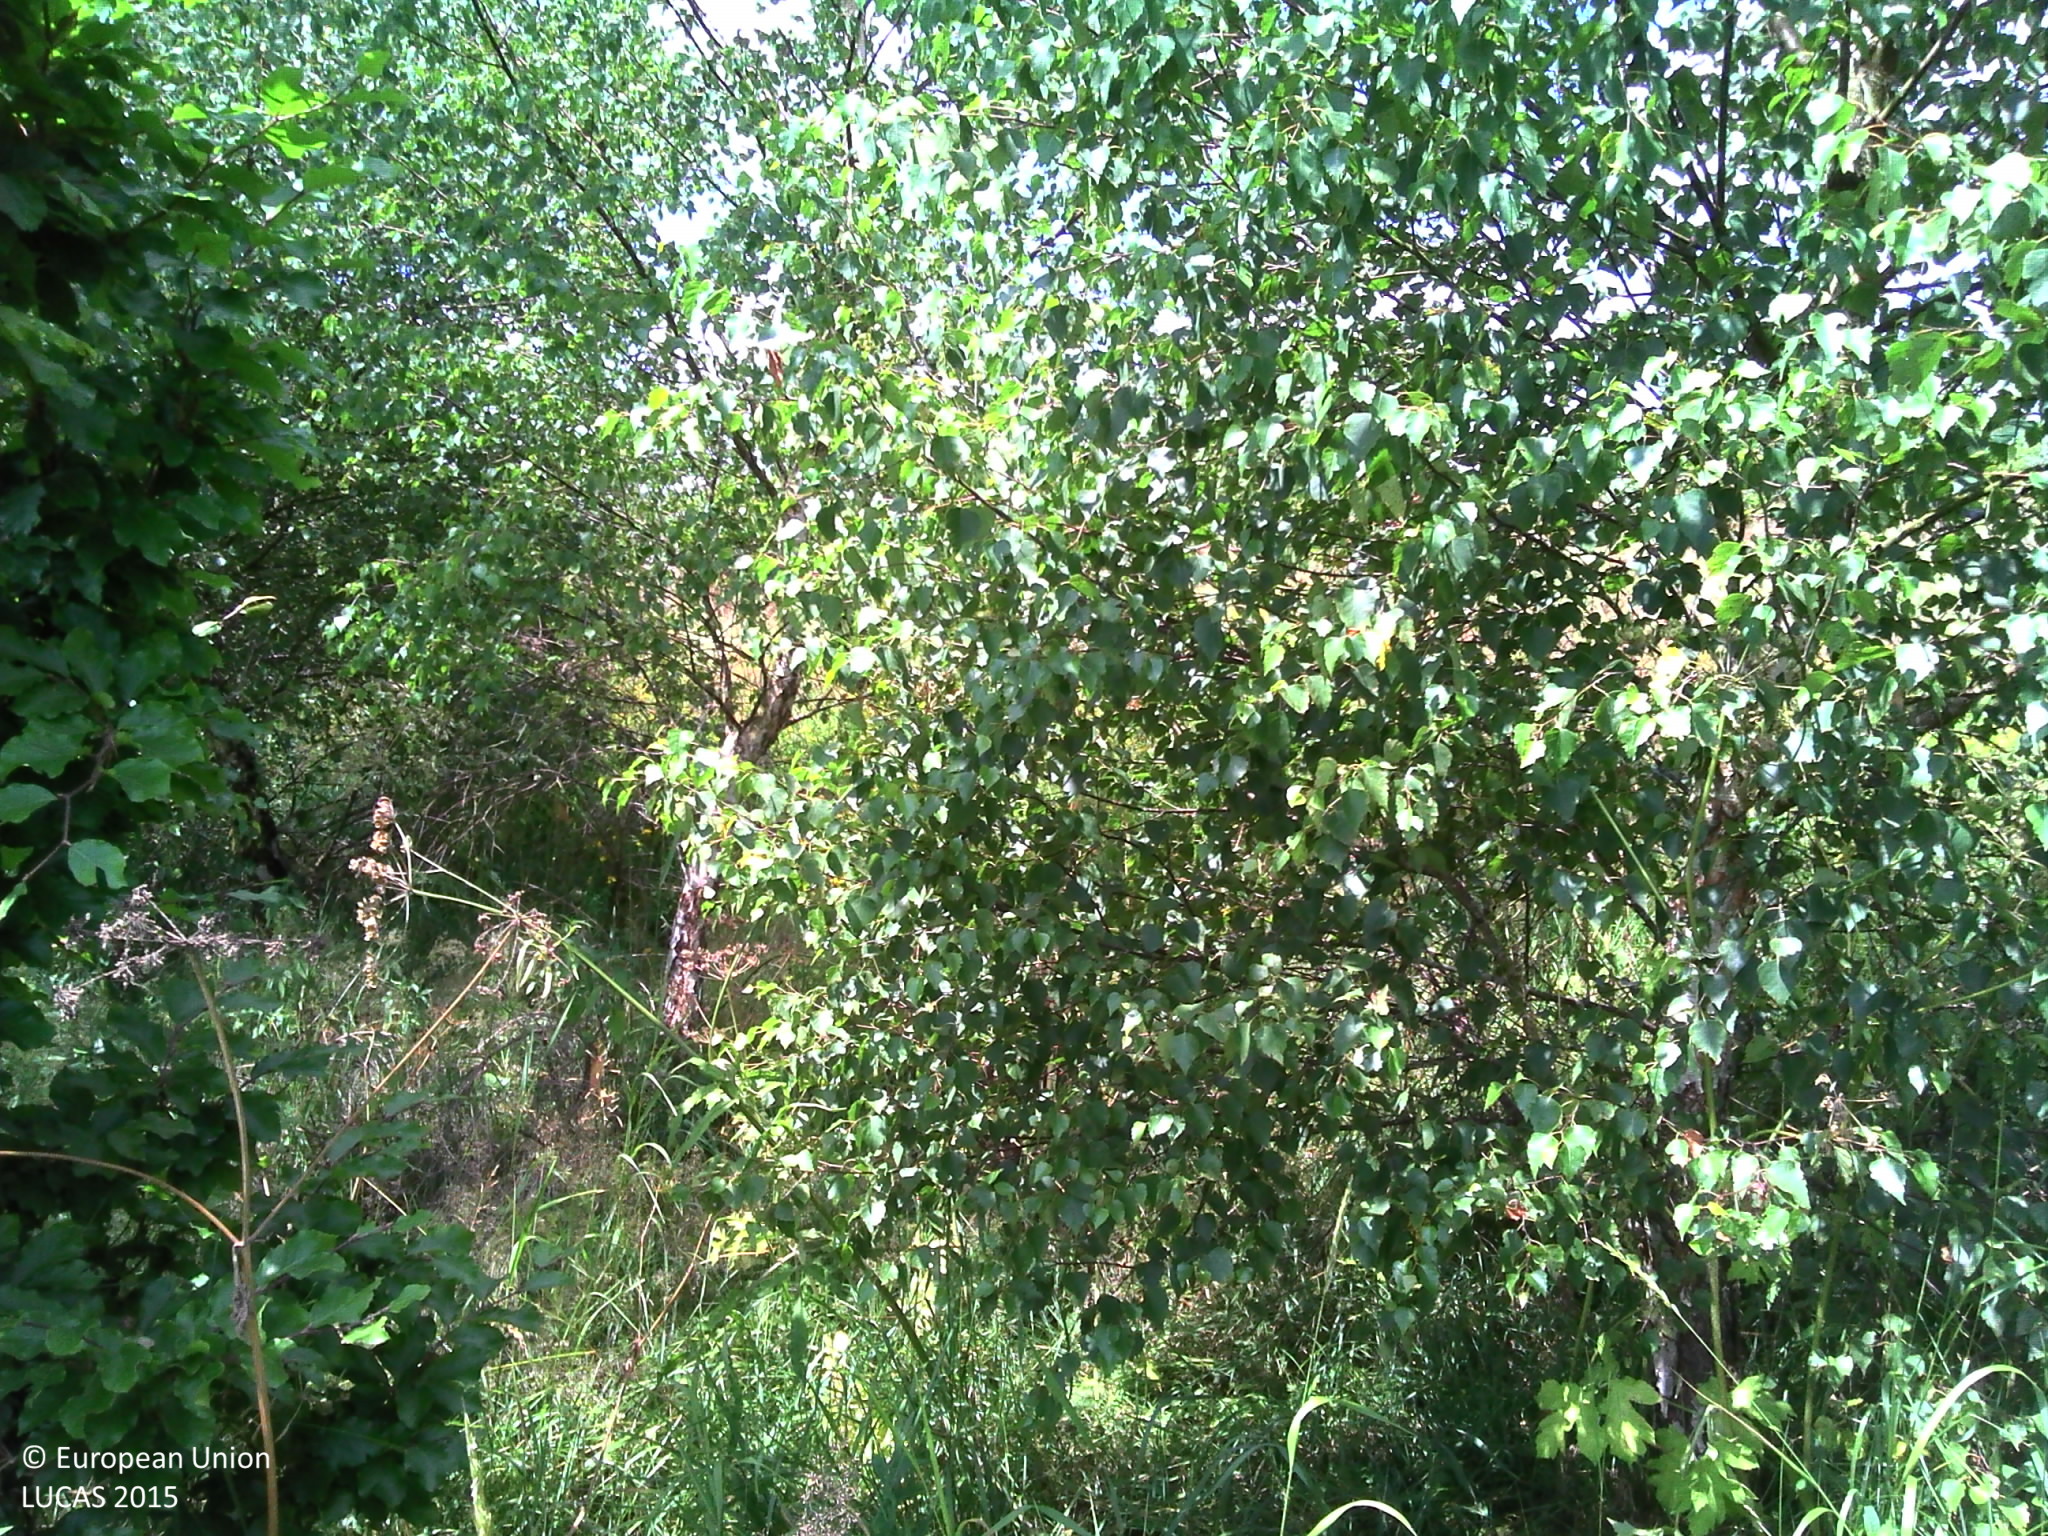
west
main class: Woodland
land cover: Broadleaved woodland
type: exotic forest
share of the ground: 10 - 25 %
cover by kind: herbaceous plants 75 %, broadleaved forest trees 20 %, shrubs 5 %
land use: Forestry
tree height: < 5 m
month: July
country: BE
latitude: 49.9989
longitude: 5.7996
